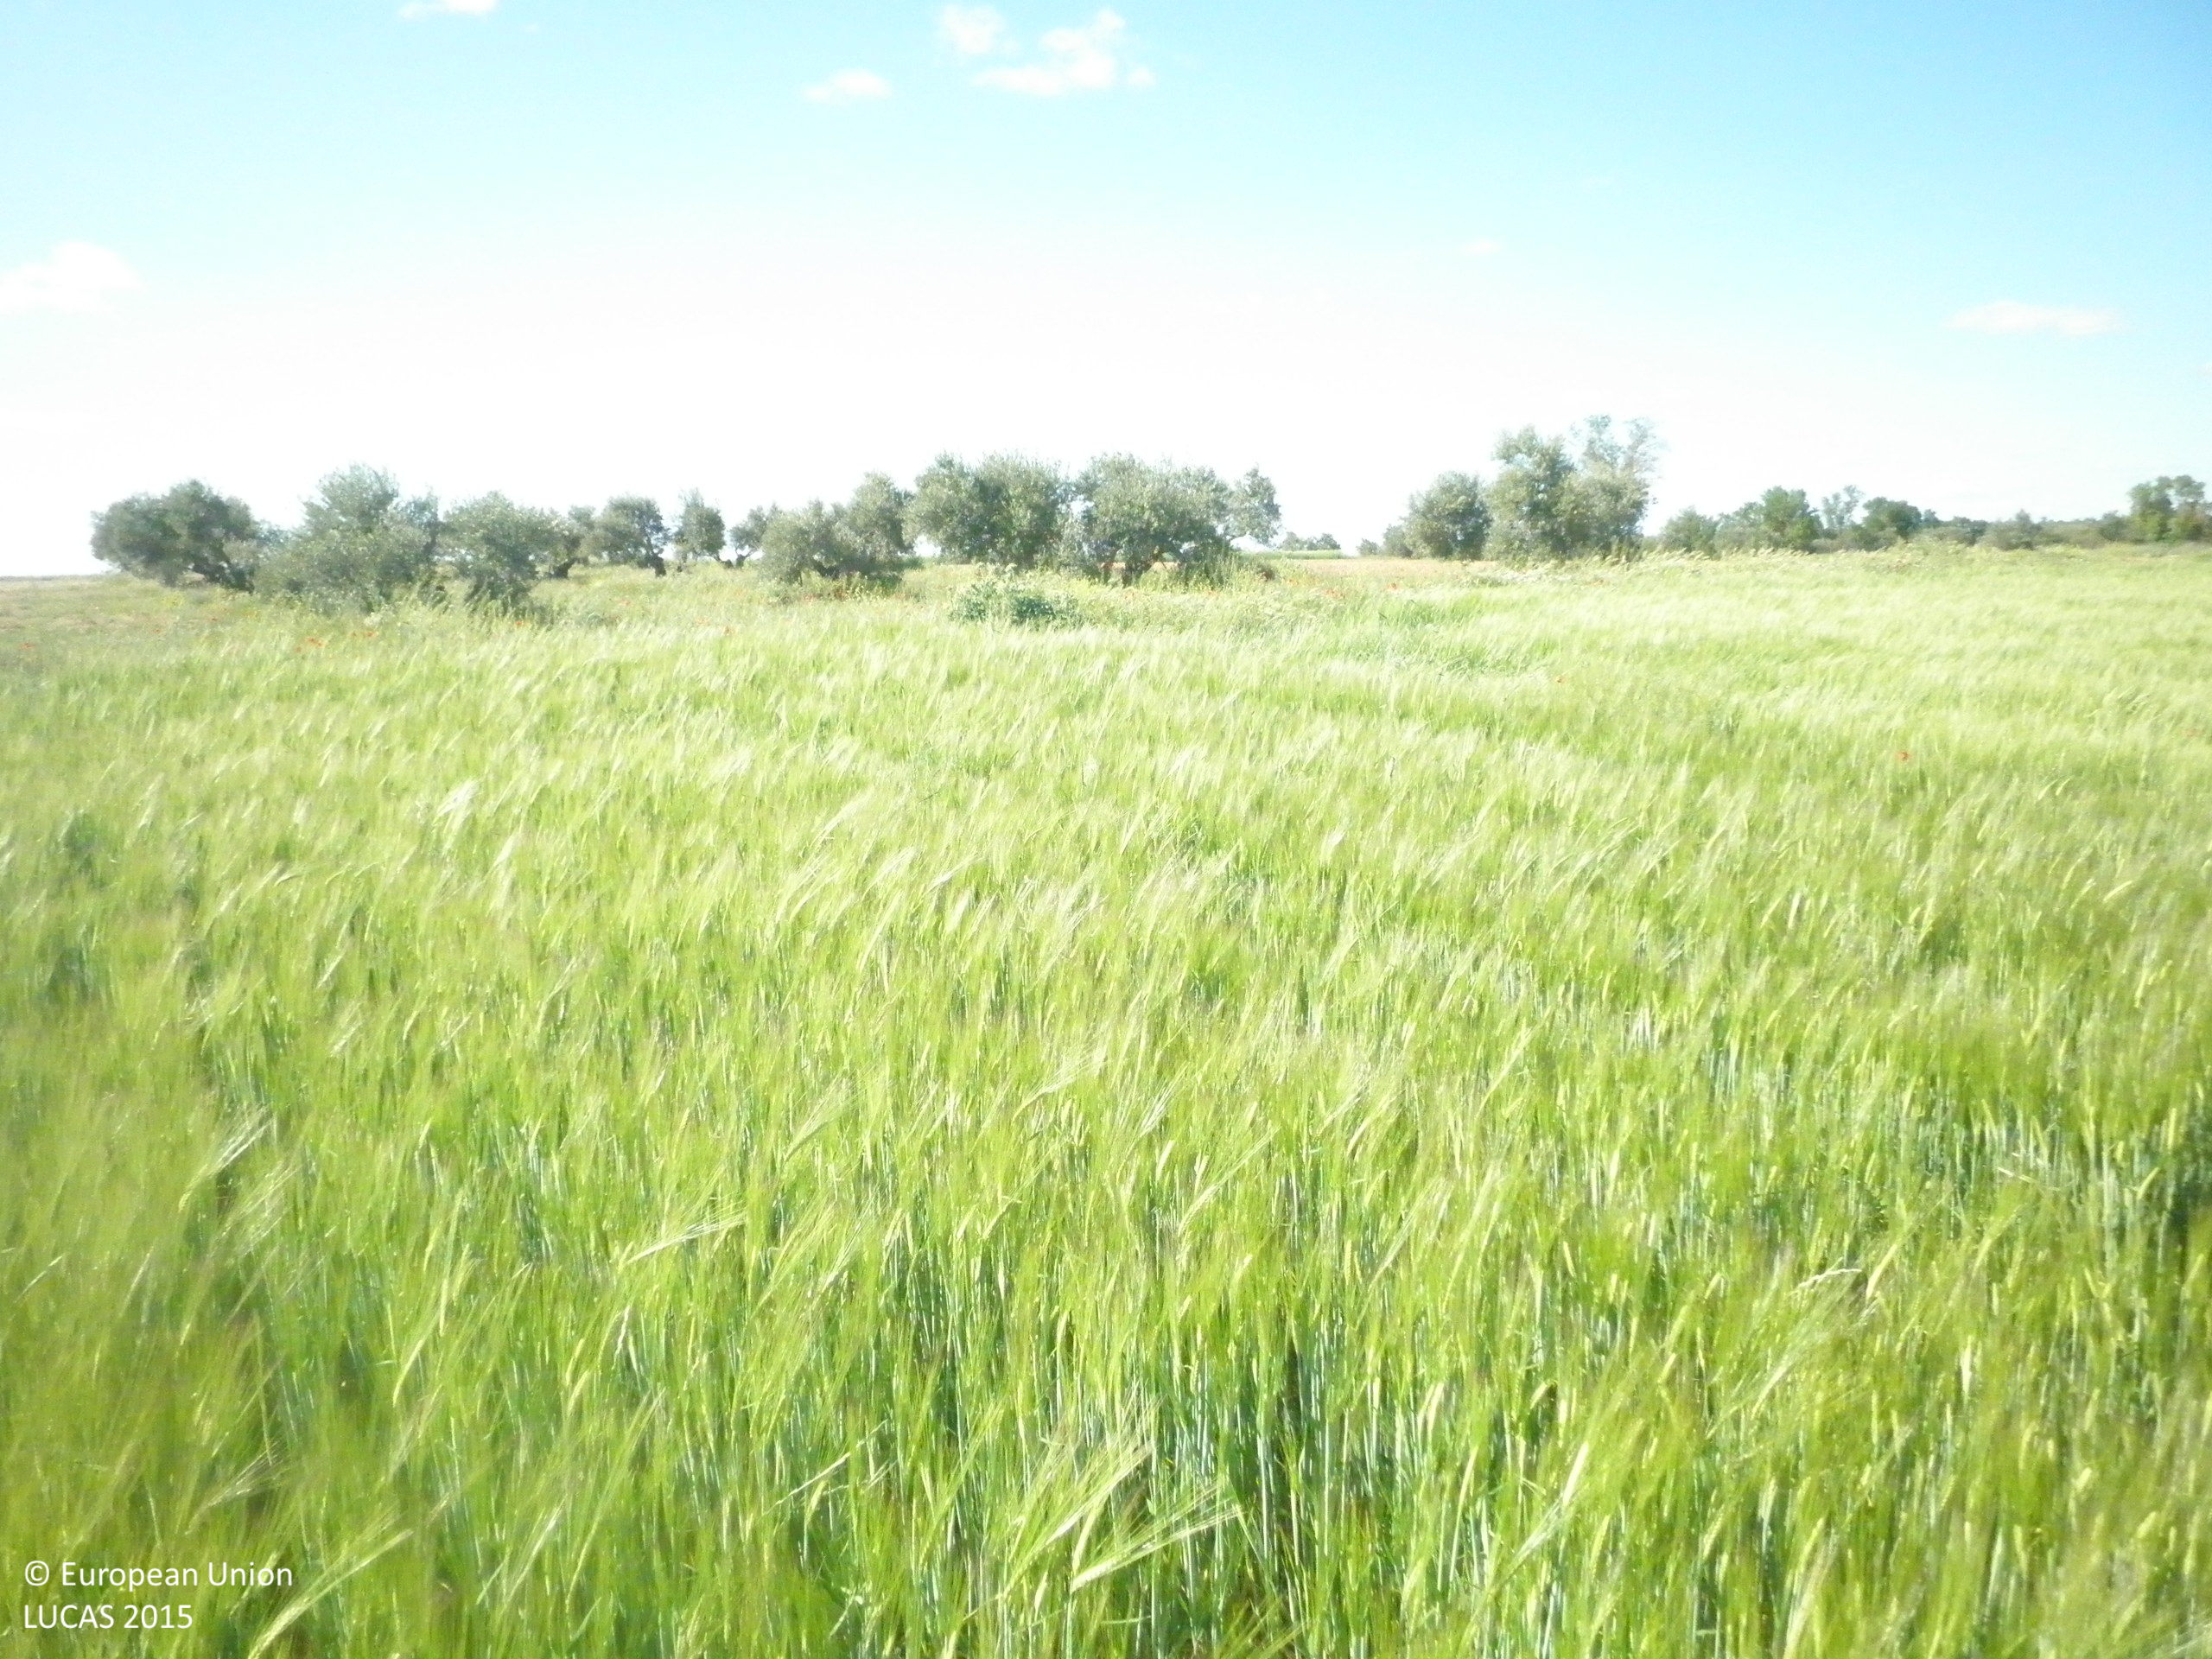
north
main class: Cropland
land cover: Barley
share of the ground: > 75 %
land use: Agriculture (excluding fallow land and kitchen gardens)
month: May
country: ES
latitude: 39.6716
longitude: -2.7351
